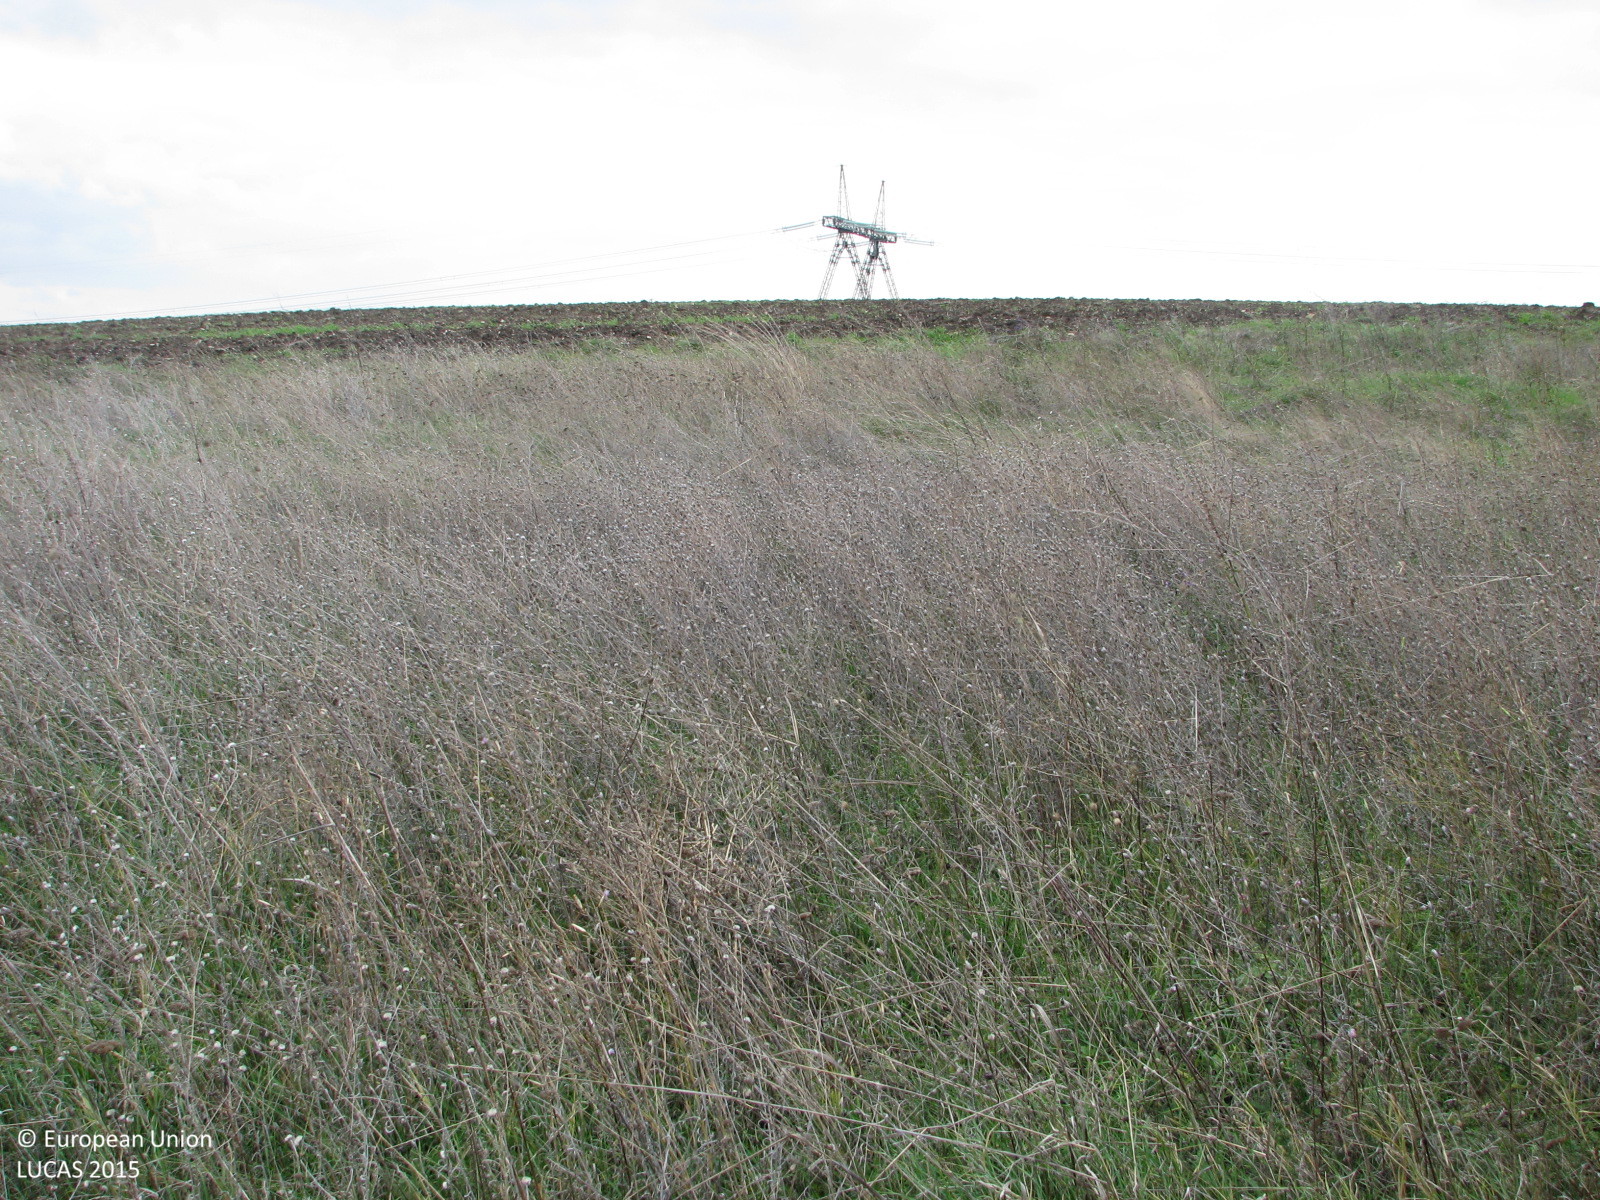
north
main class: Grassland
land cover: Grassland with sparse tree/shrub cover
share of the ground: > 75 %
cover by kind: herbaceous plants 90 %, broadleaved forest trees 5 %, shrubs 5 %
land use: Semi-natural and natural areas not in use
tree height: < 5 m
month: October
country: BG
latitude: 42.2304
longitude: 26.7056
